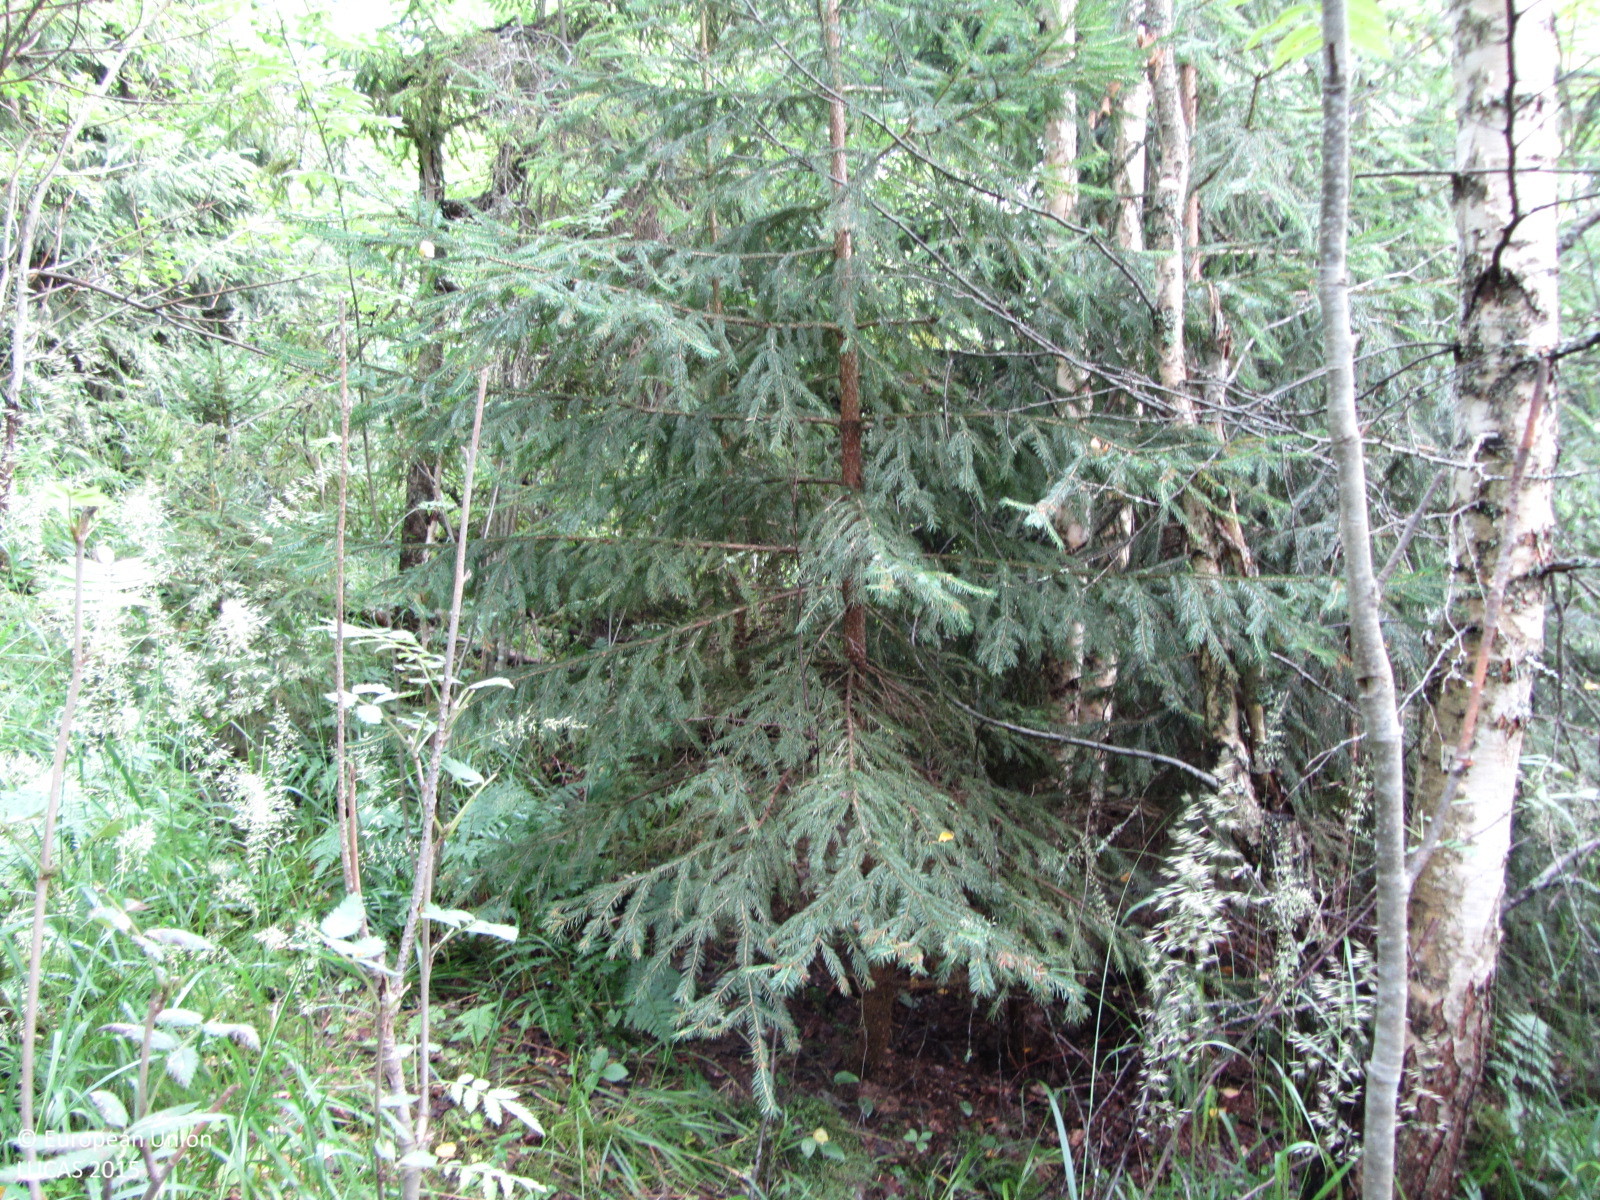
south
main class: Woodland
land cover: Broadleaved woodland
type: boreal forest
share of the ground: > 75 %
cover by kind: broadleaved forest trees 85 %, herbaceous plants 10 %, coniferous forest trees 5 %
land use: Forestry
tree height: > 5 m
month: July
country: FI
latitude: 60.4730
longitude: 24.3092
